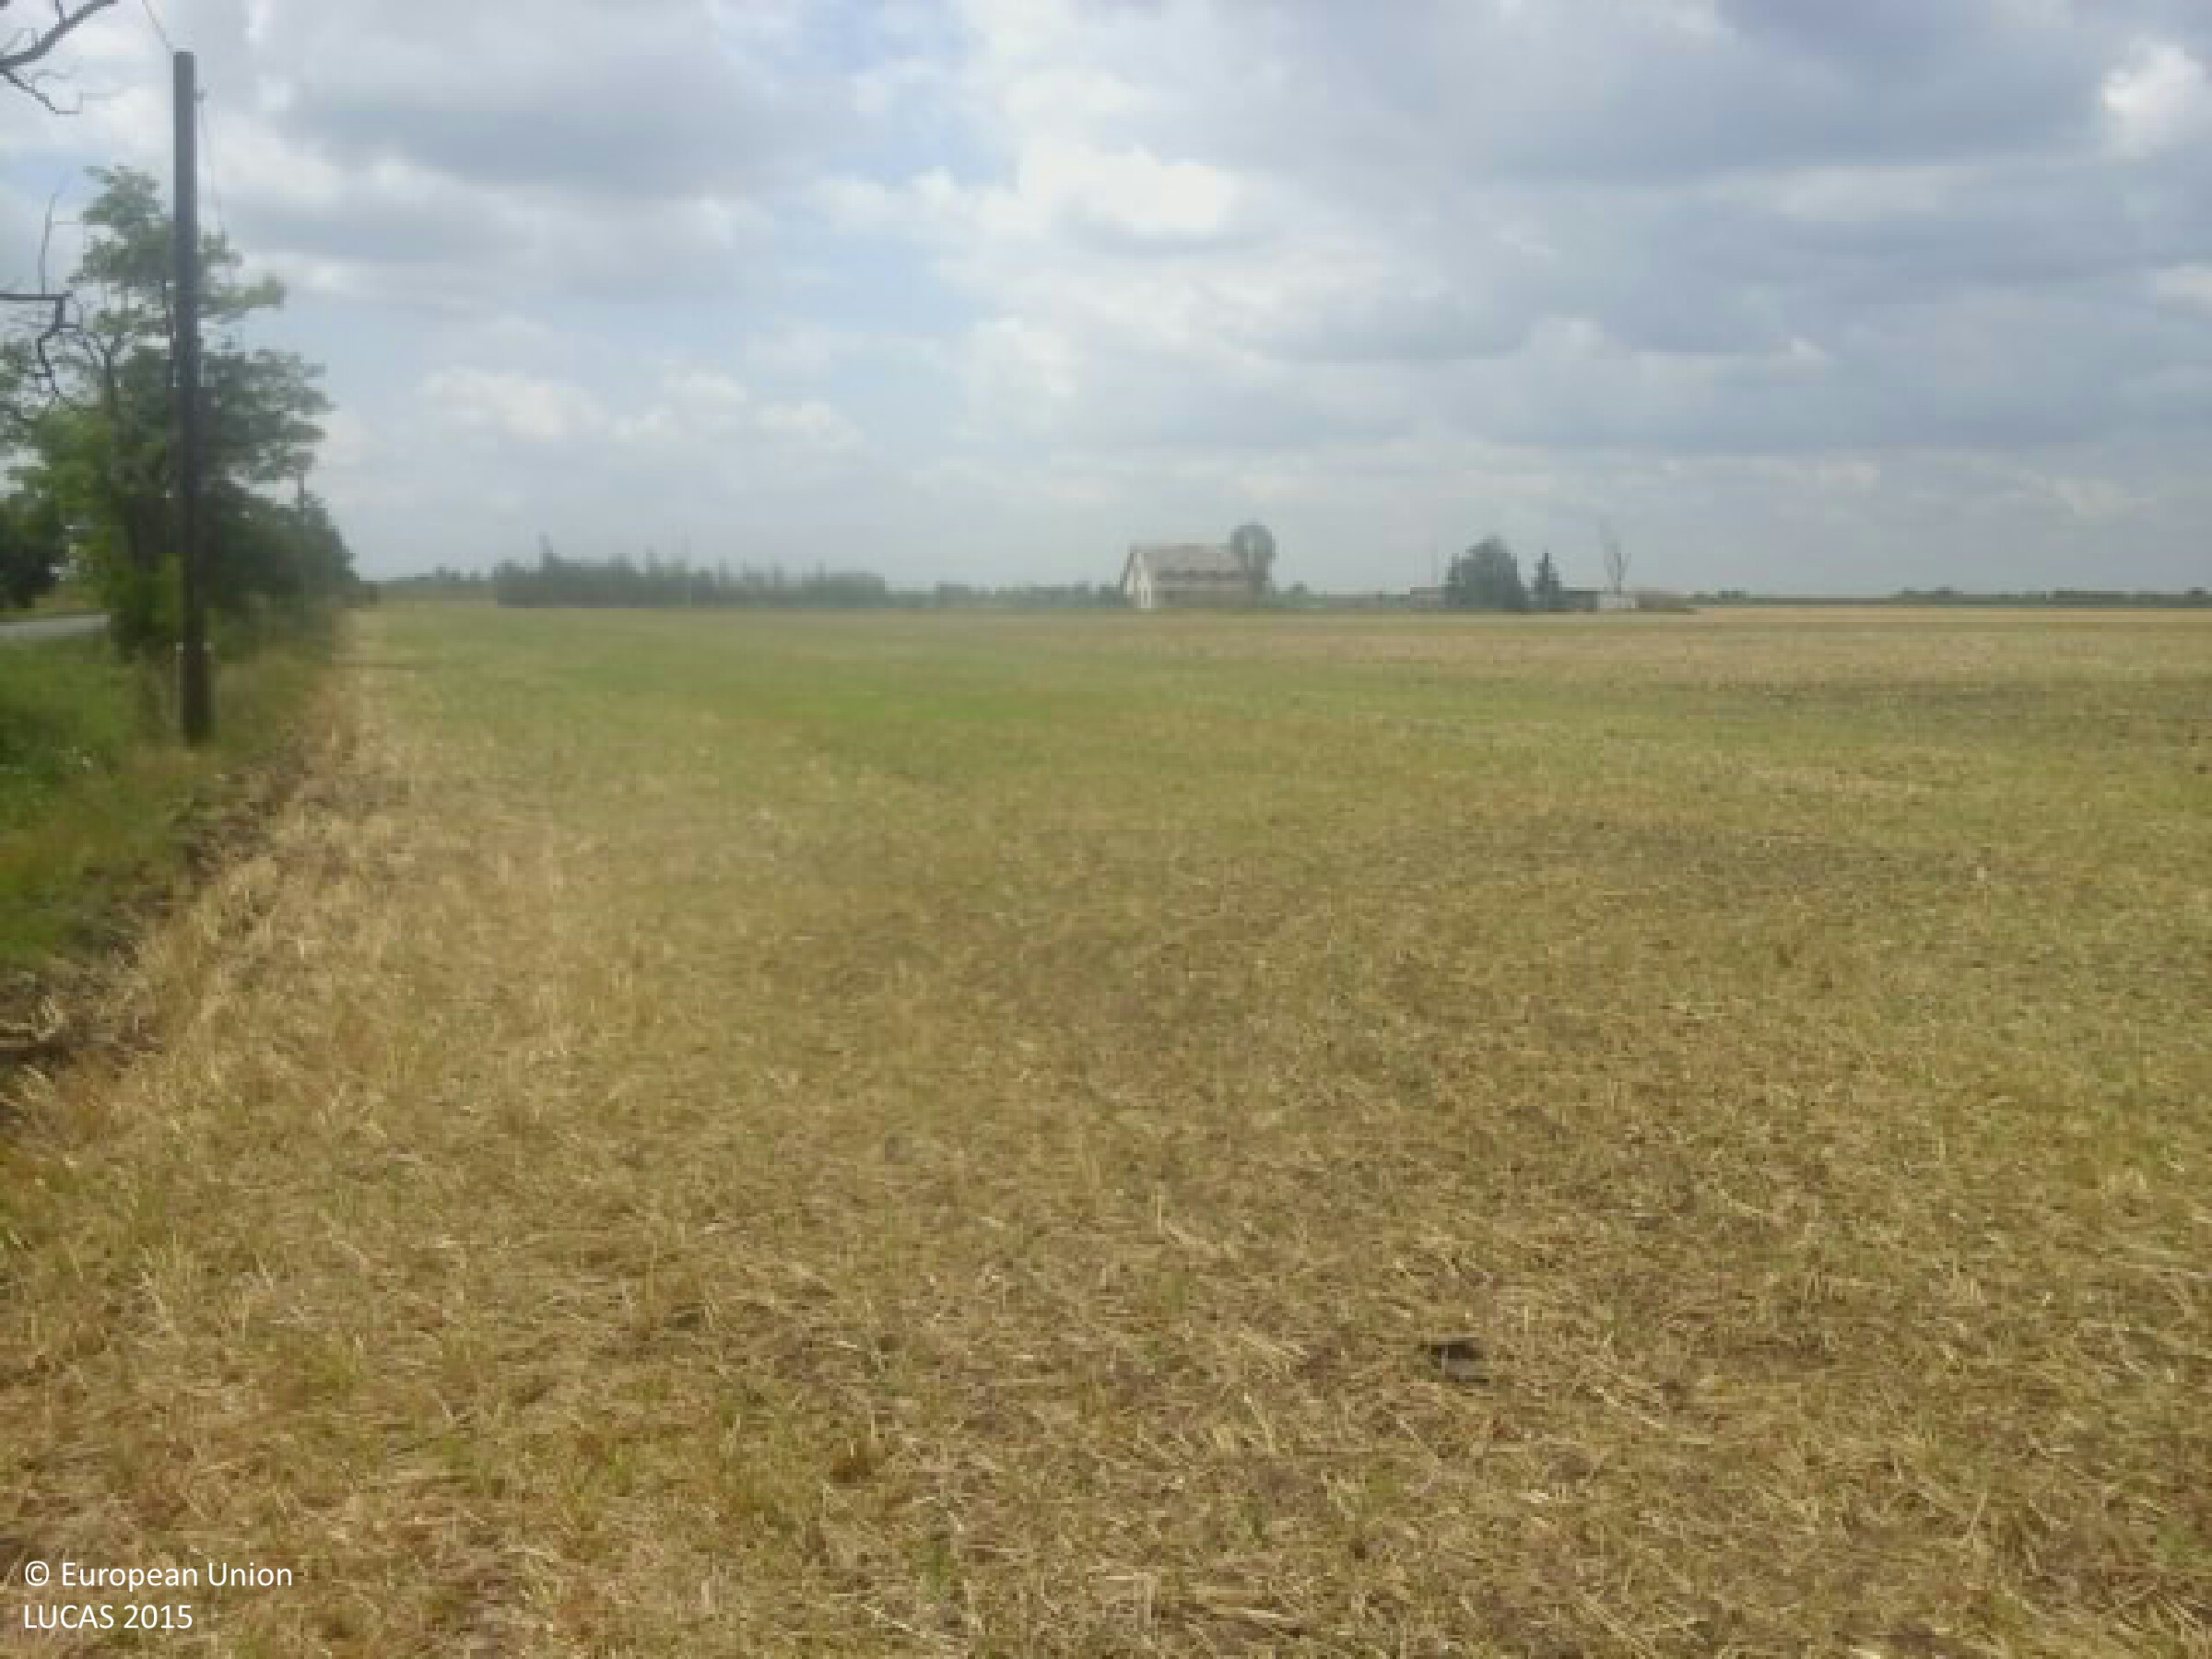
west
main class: Cropland
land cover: Barley
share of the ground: 10 - 25 %
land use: Agriculture (excluding fallow land and kitchen gardens)
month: July
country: HU
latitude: 46.4877
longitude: 20.6716
